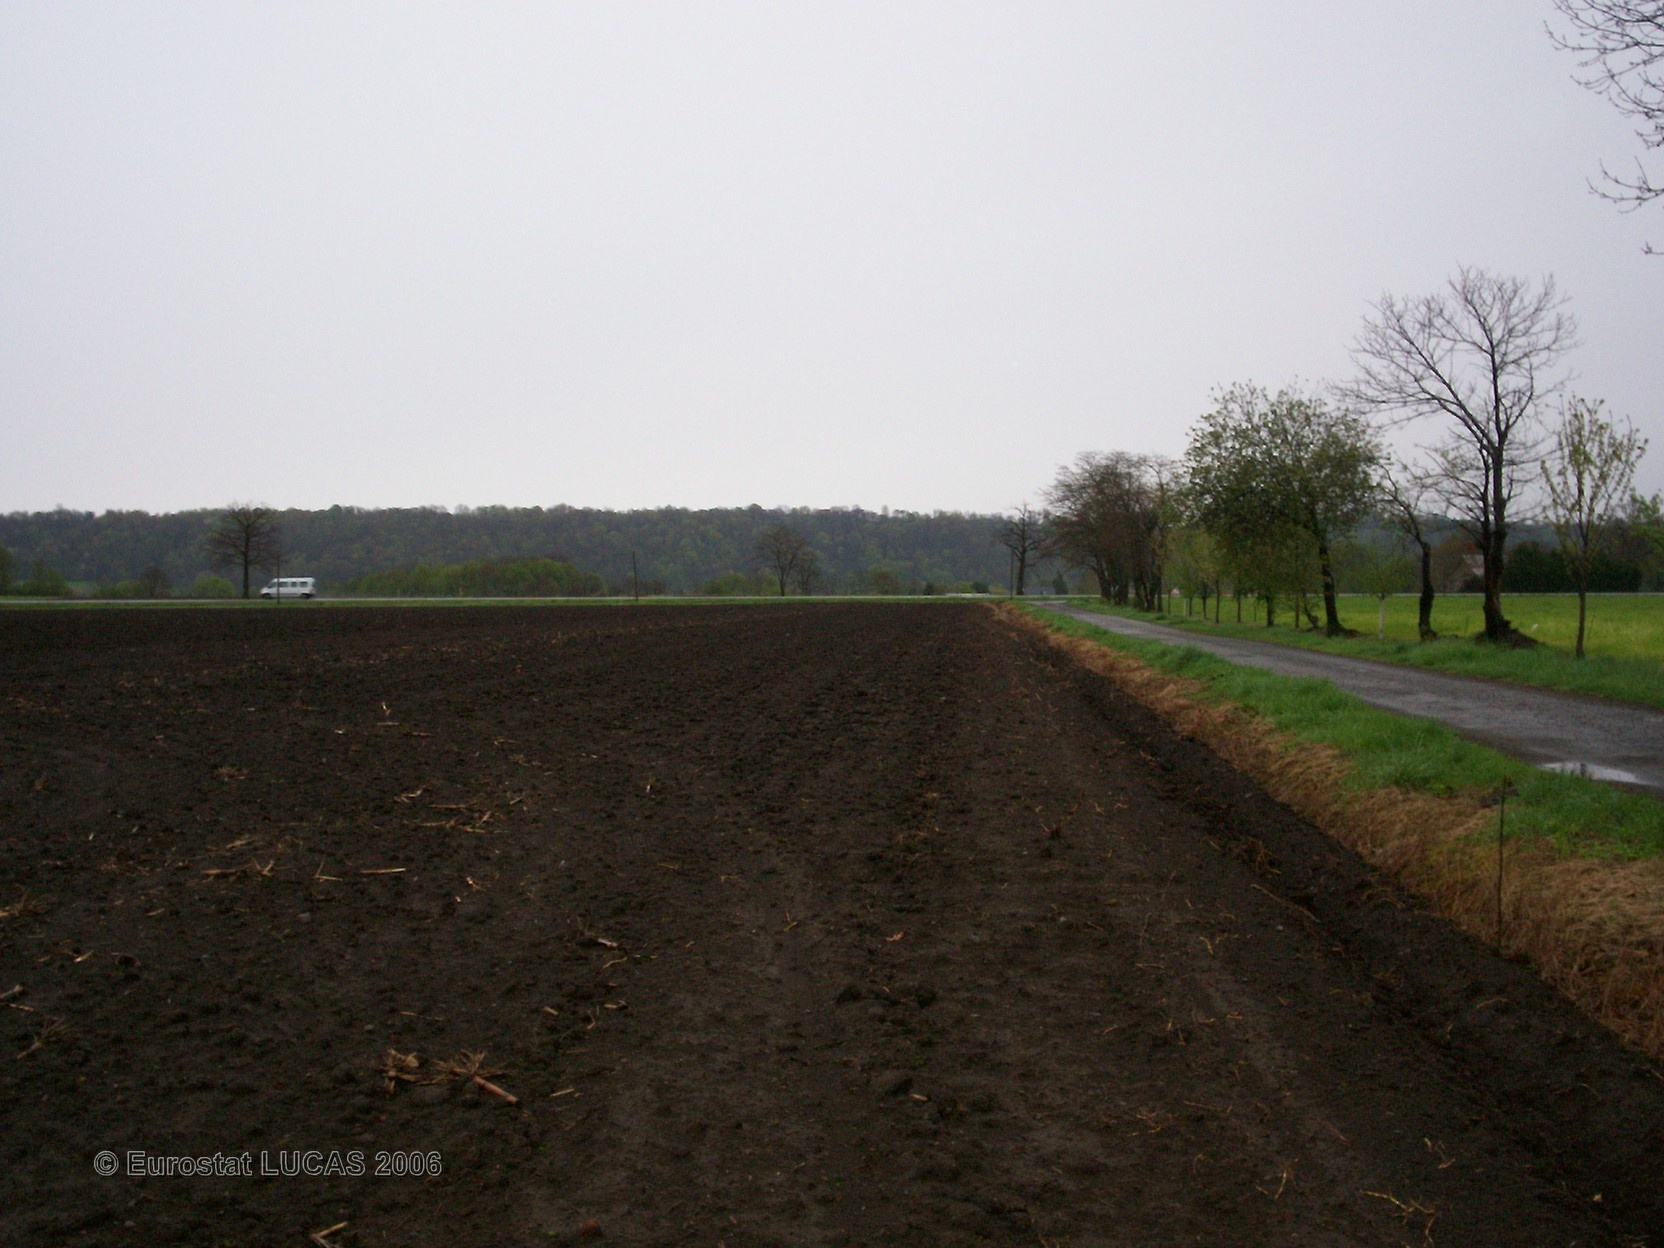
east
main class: Cropland
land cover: Maize
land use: Agriculture (excluding fallow land and kitchen gardens)
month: June
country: FR
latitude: 43.1992
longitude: -0.1326
